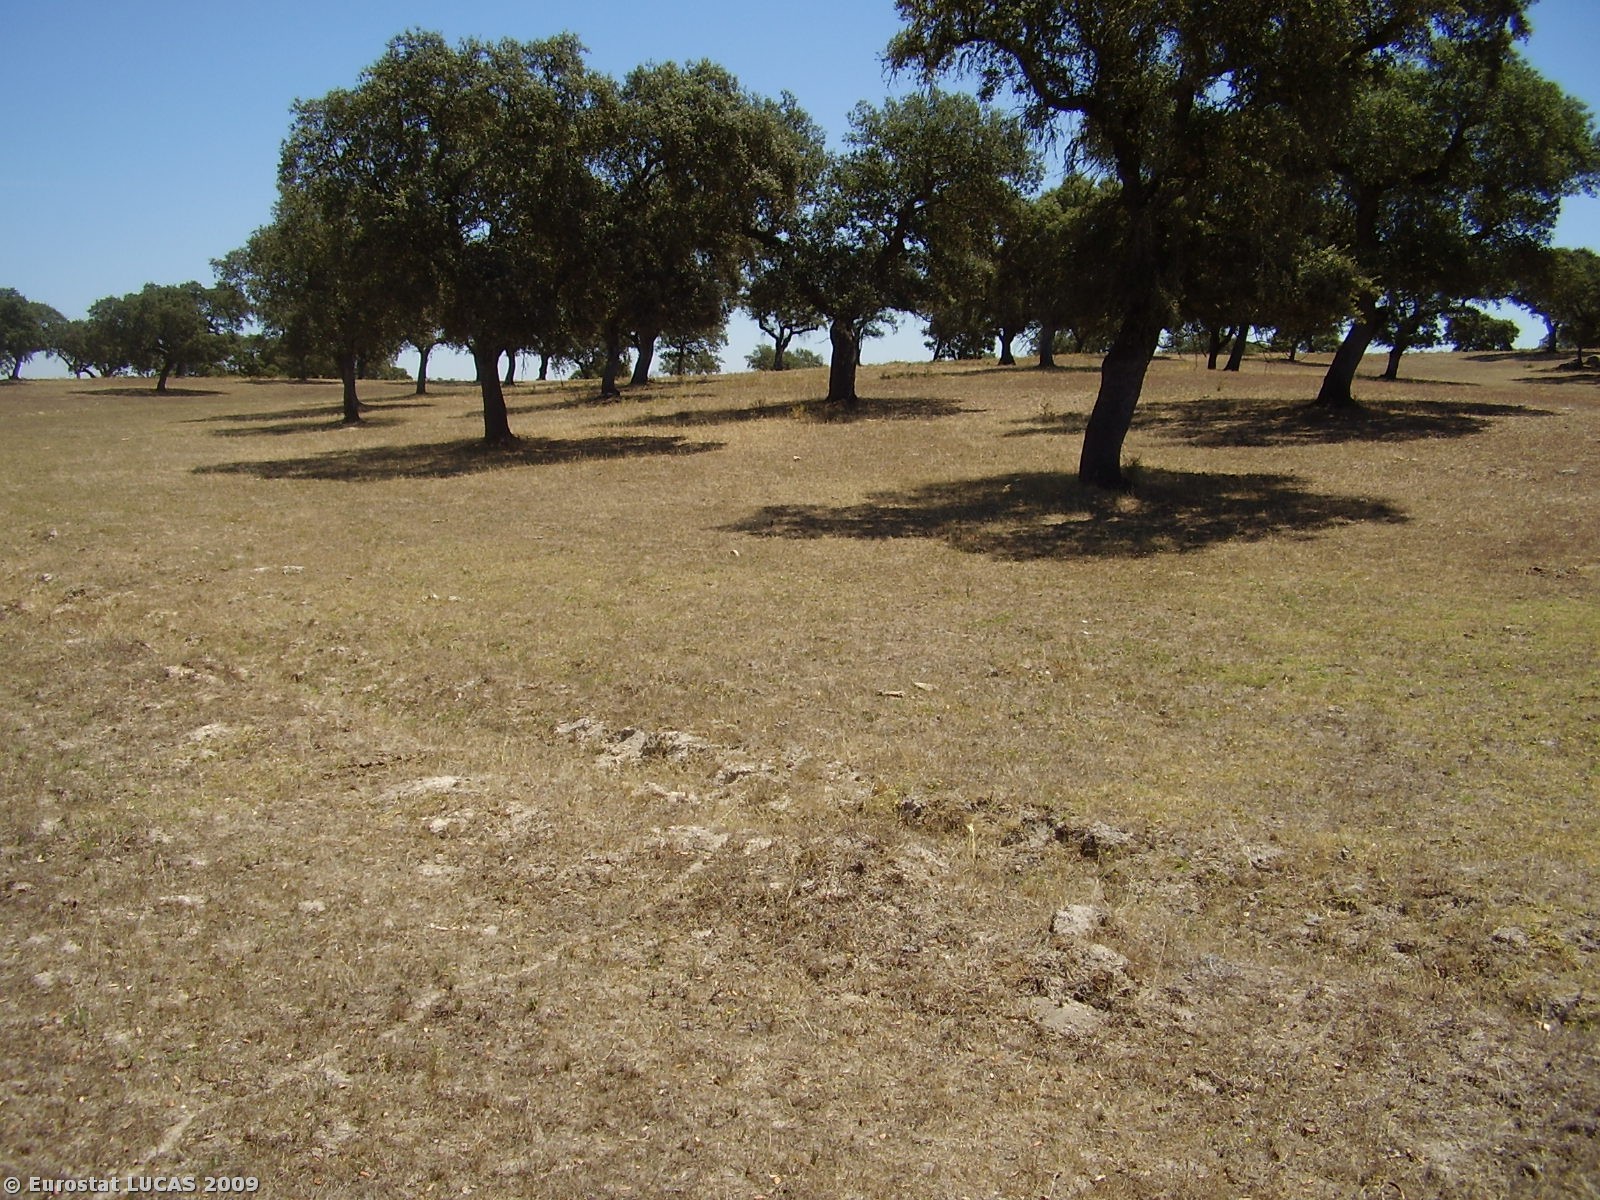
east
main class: Woodland
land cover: Broadleaved woodland
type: broadleaved evergreen forest
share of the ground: 10 - 25 %
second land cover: Grassland with sparse tree/shrub cover
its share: 50 - 75 %
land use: Forestry
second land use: Fallow land
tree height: > 5 m
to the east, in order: Broadleaved woodland; Grassland with sparse tree/shrub cover; Broadleaved woodland; Tracks; Broadleaved woodland; Grassland without tree/shrub cover
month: July
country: PT
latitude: 38.8392
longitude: -7.9369
